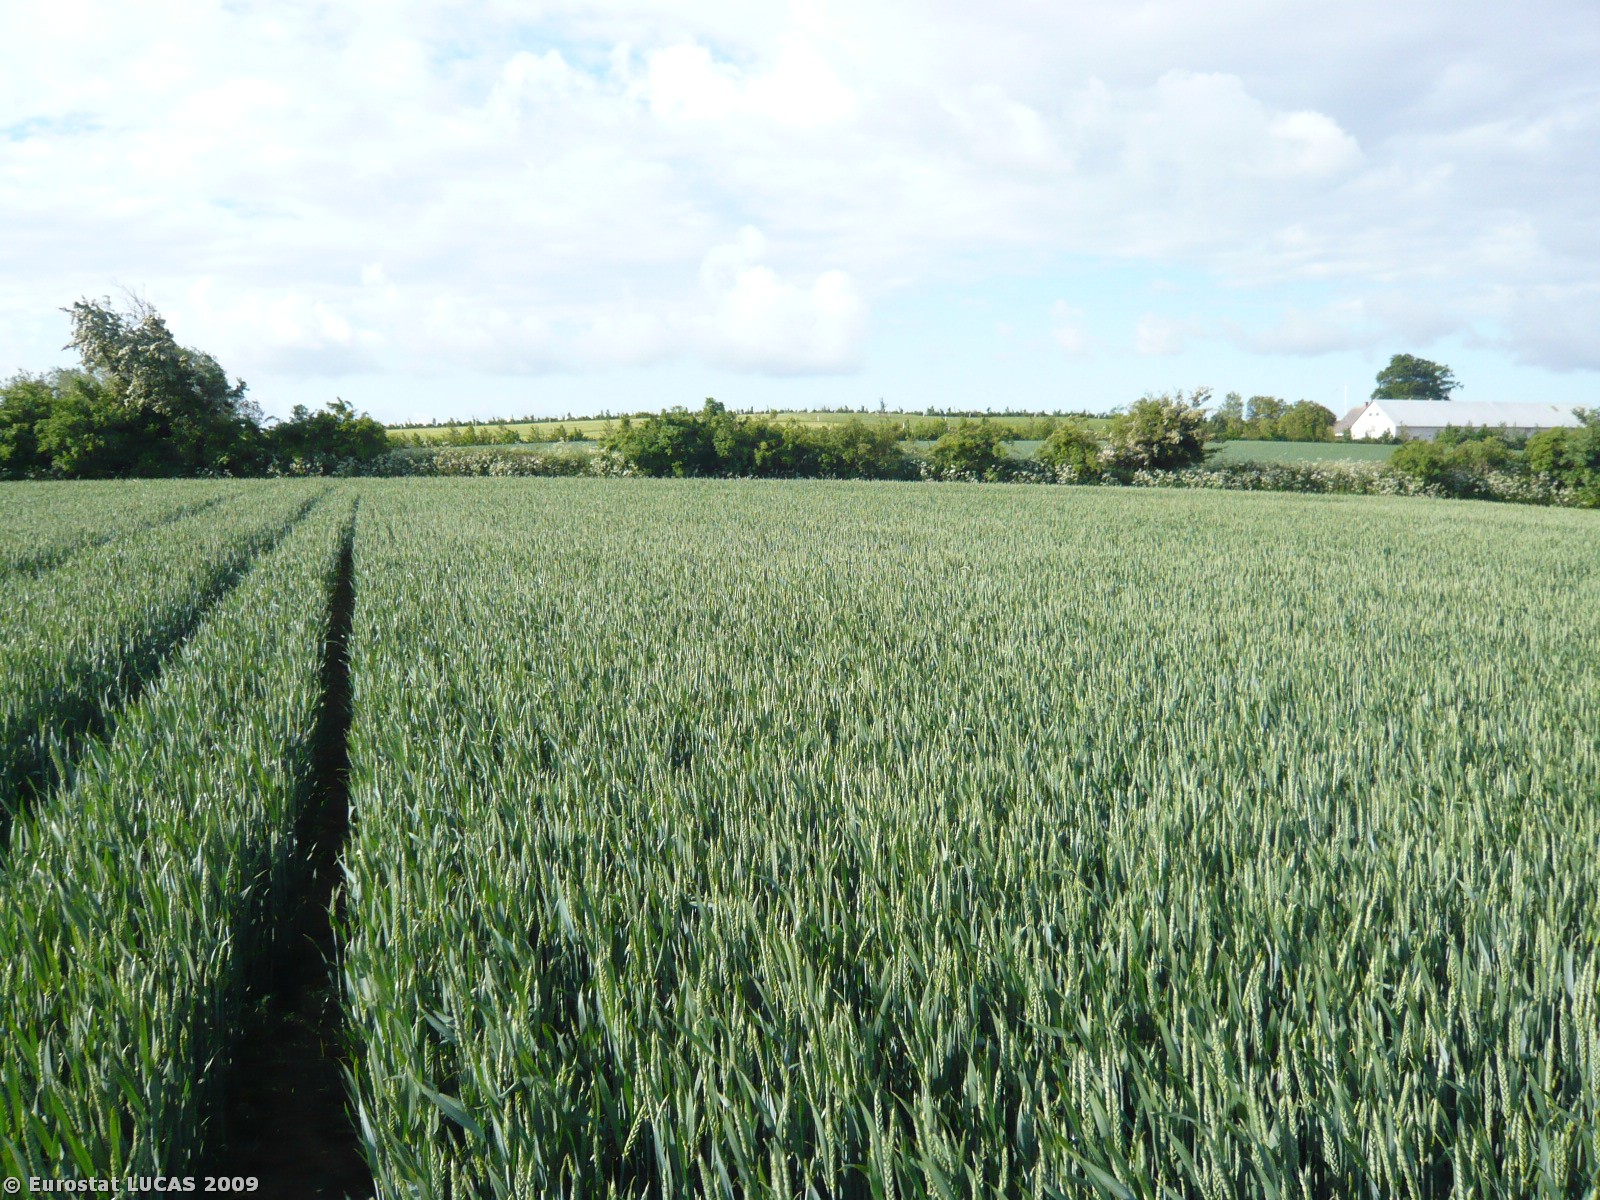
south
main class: Cropland
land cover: Common wheat
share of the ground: > 75 %
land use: Agriculture (excluding fallow land and kitchen gardens)
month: June
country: DK
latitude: 54.9451
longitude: 12.2623
